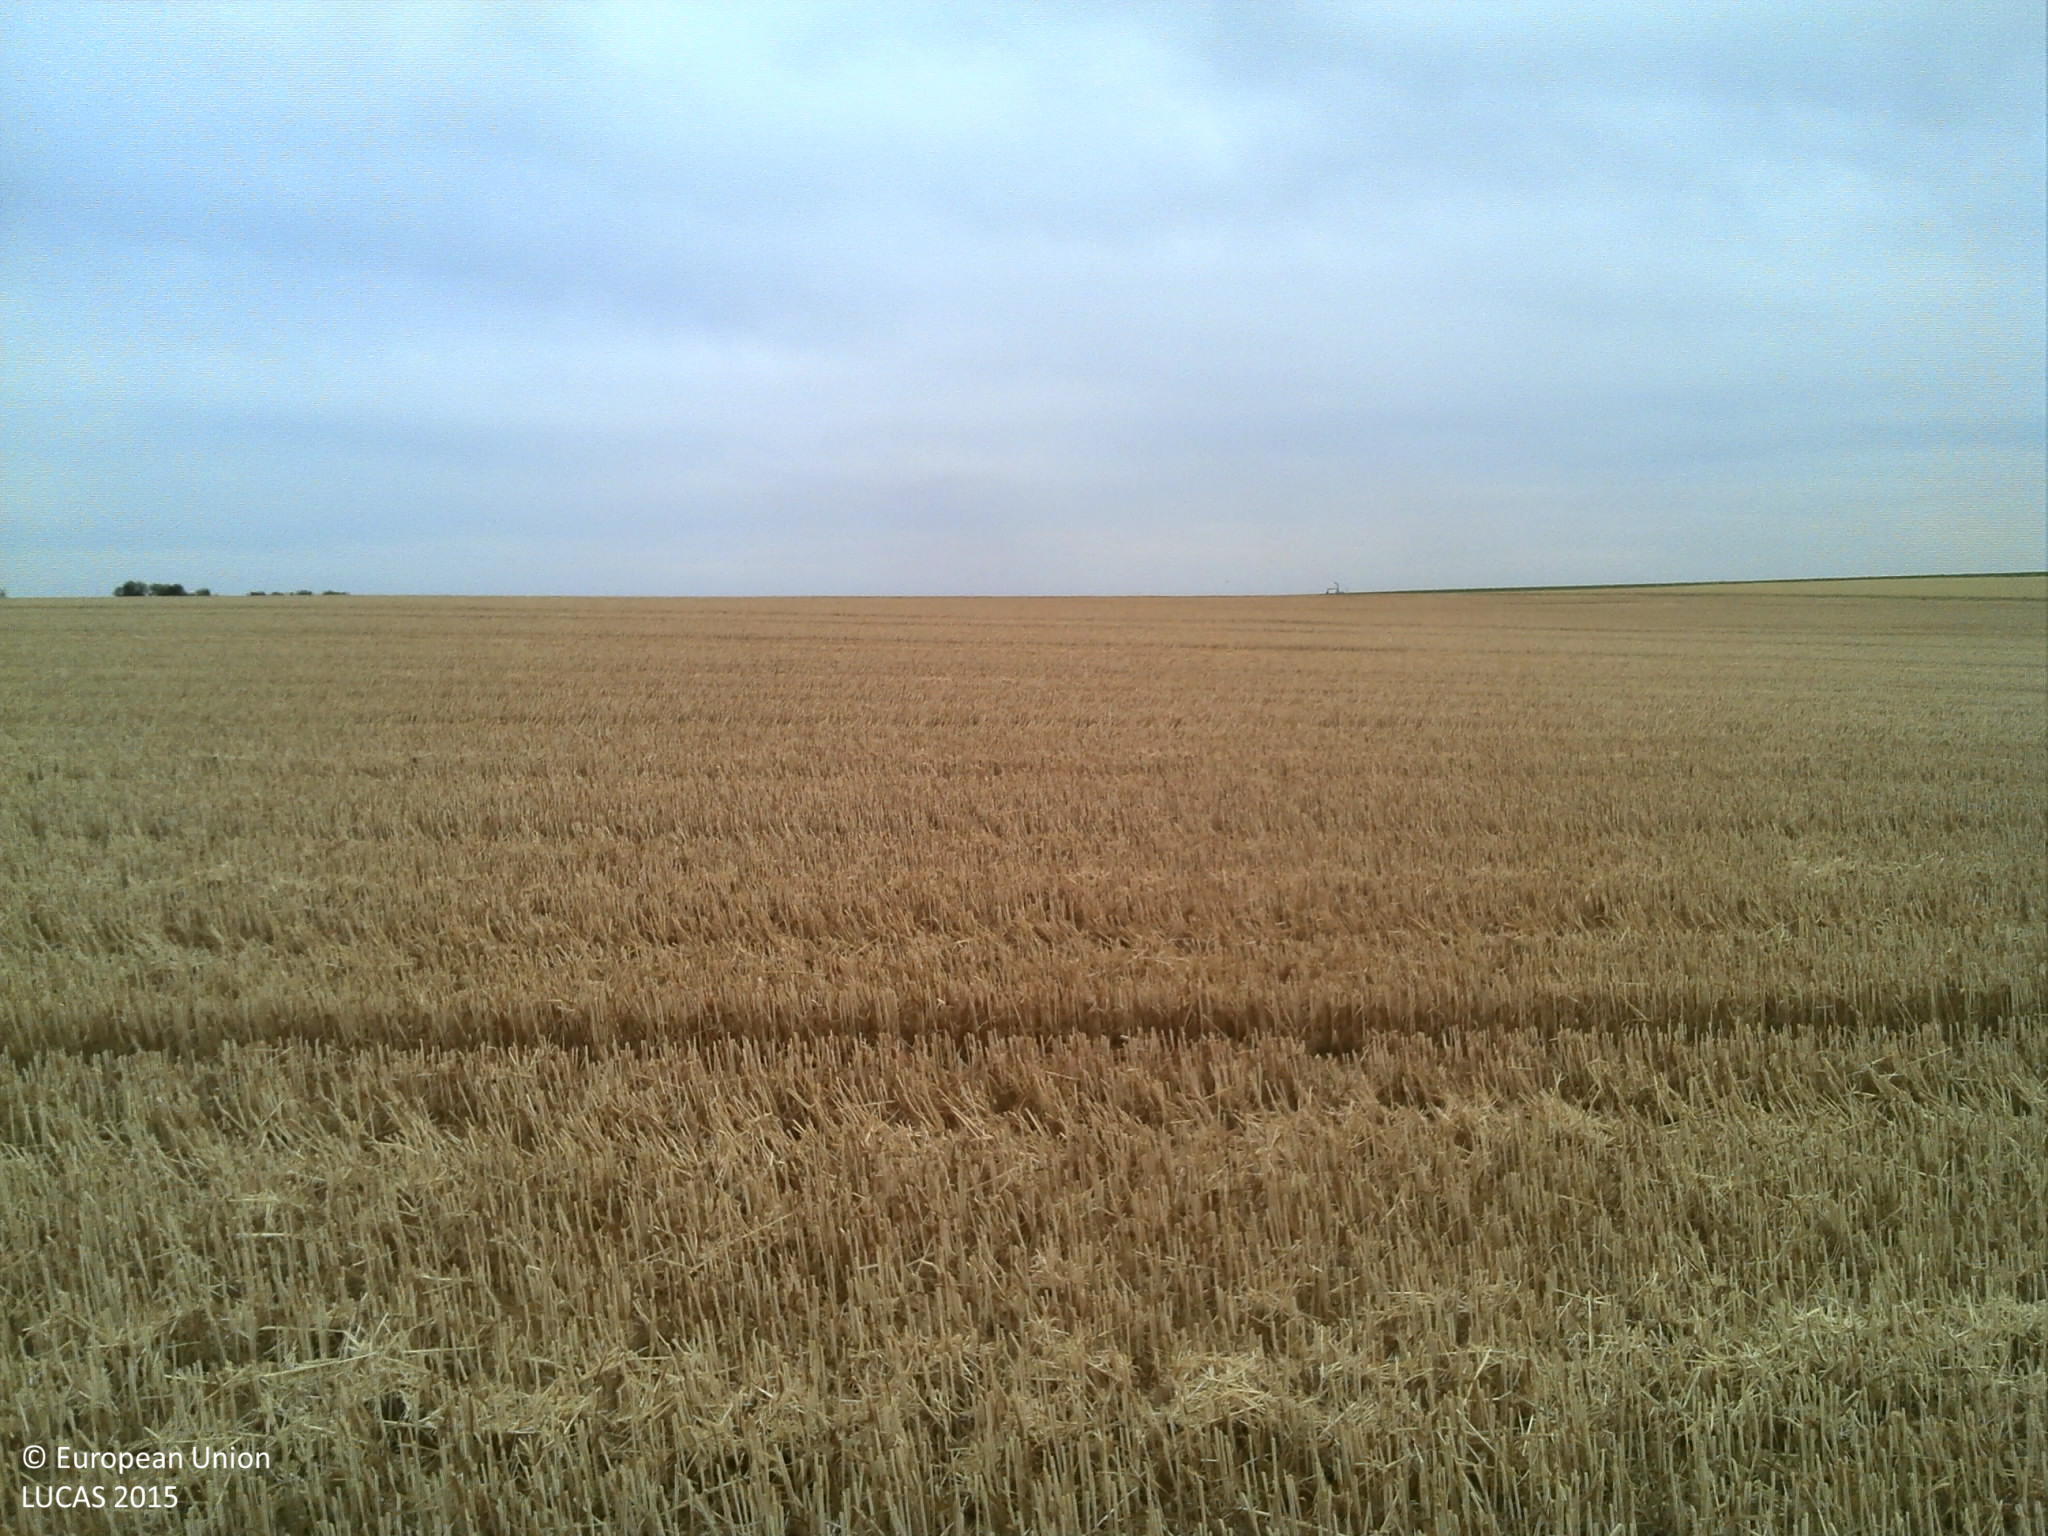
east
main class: Cropland
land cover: Common wheat
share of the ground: > 75 %
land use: Agriculture (excluding fallow land and kitchen gardens)
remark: Harvested field
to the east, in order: Common wheat; Grass margins; Tracks; Grass margins; Barley
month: July
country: FR
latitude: 49.4991
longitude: 4.2654
